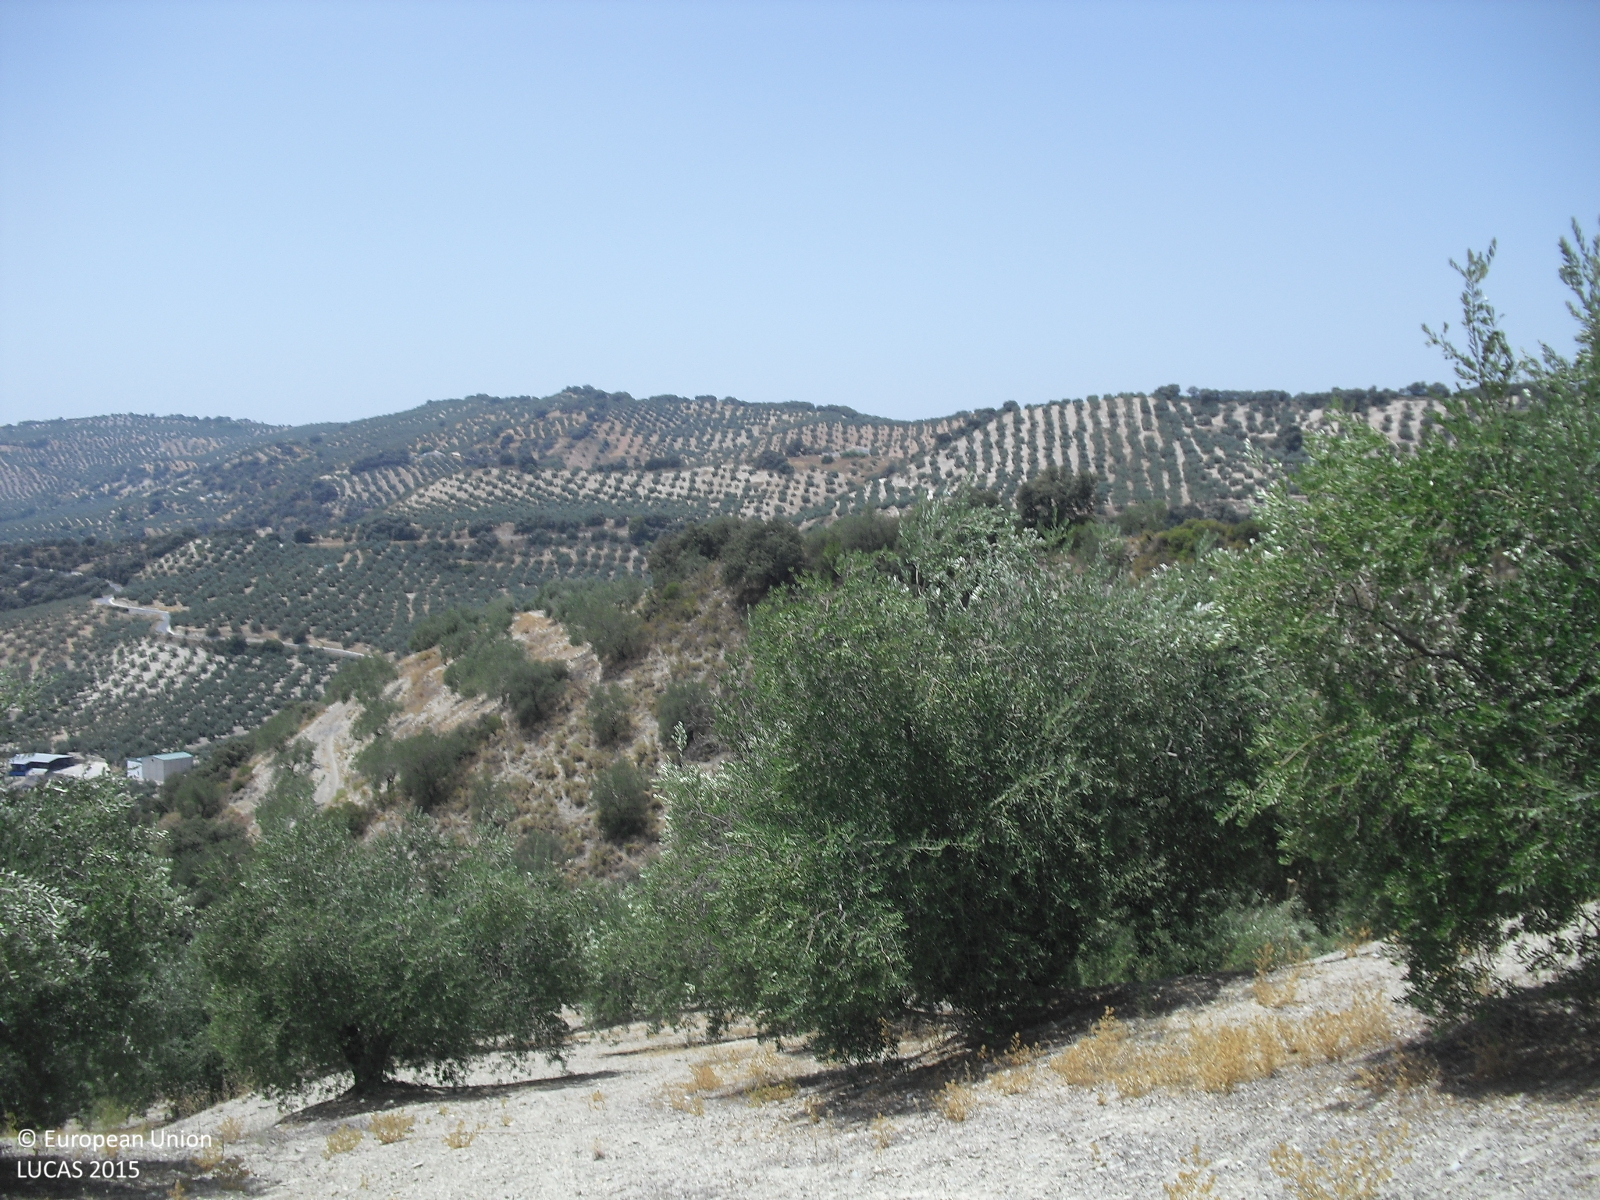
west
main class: Cropland
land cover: Olive groves
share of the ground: 25 - 50 %
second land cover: Other bare soil
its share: > 75 %
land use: Agriculture (excluding fallow land and kitchen gardens)
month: August
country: ES
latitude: 37.3576
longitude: -4.1900
